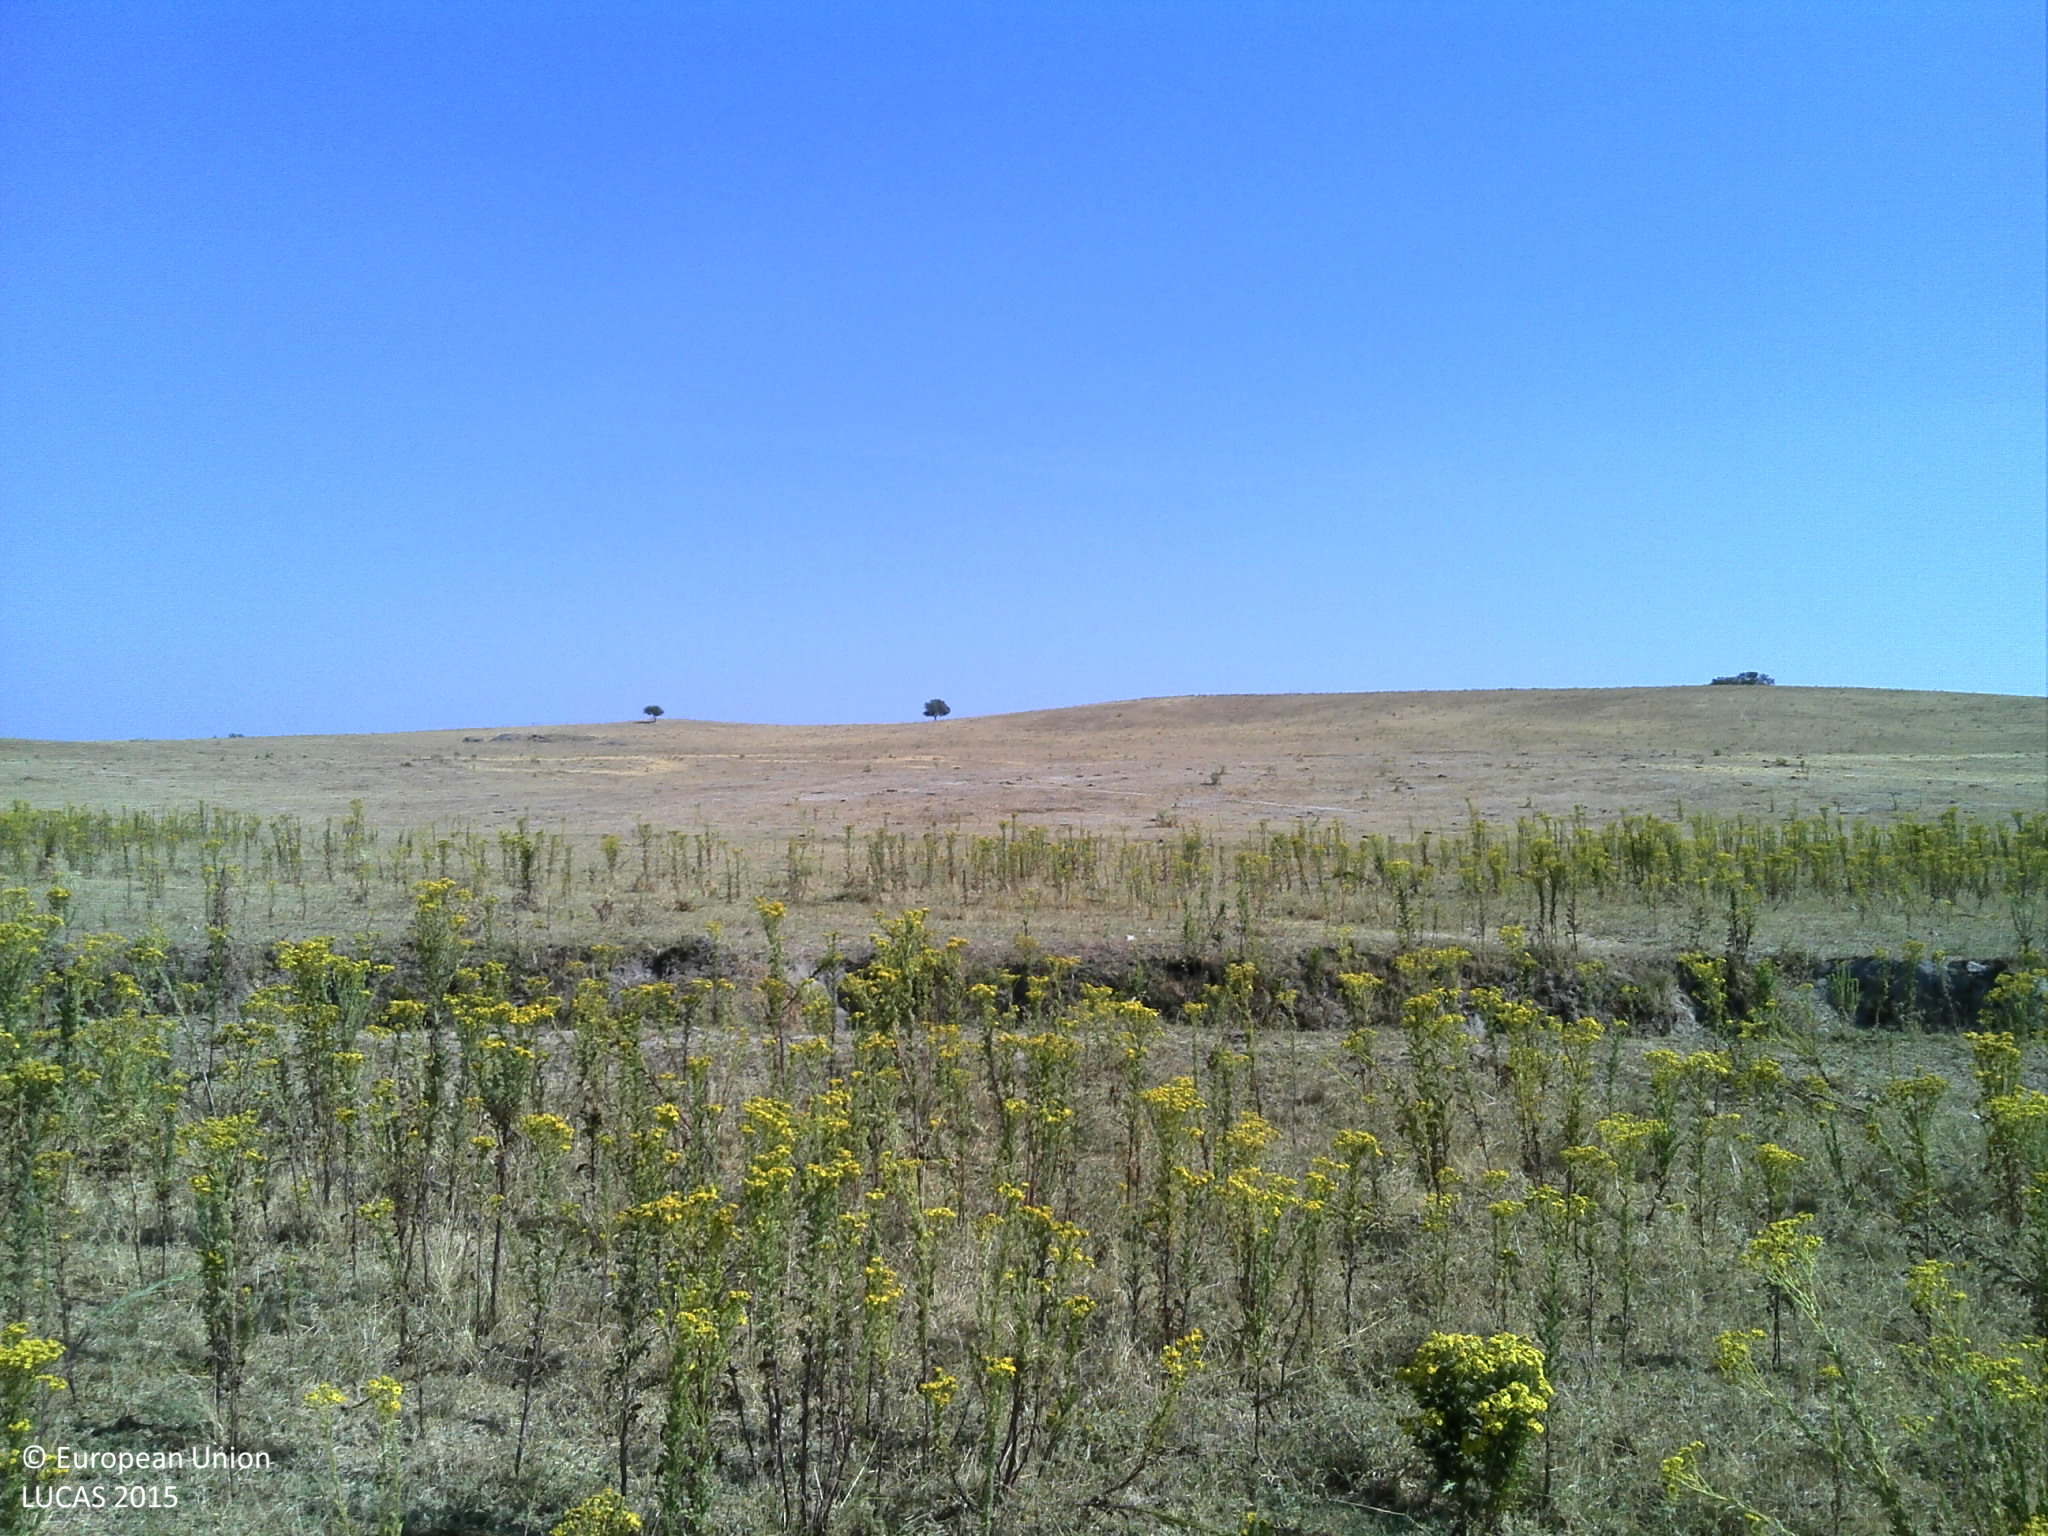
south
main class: Grassland
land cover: Grassland without tree/shrub cover
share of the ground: 25 - 50 %
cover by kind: unconsolidated bare surface 75 %, herbaceous plants 25 %
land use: Agriculture (excluding fallow land and kitchen gardens)
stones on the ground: < 10 %
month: July
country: PT
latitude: 38.5699
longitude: -7.6983
